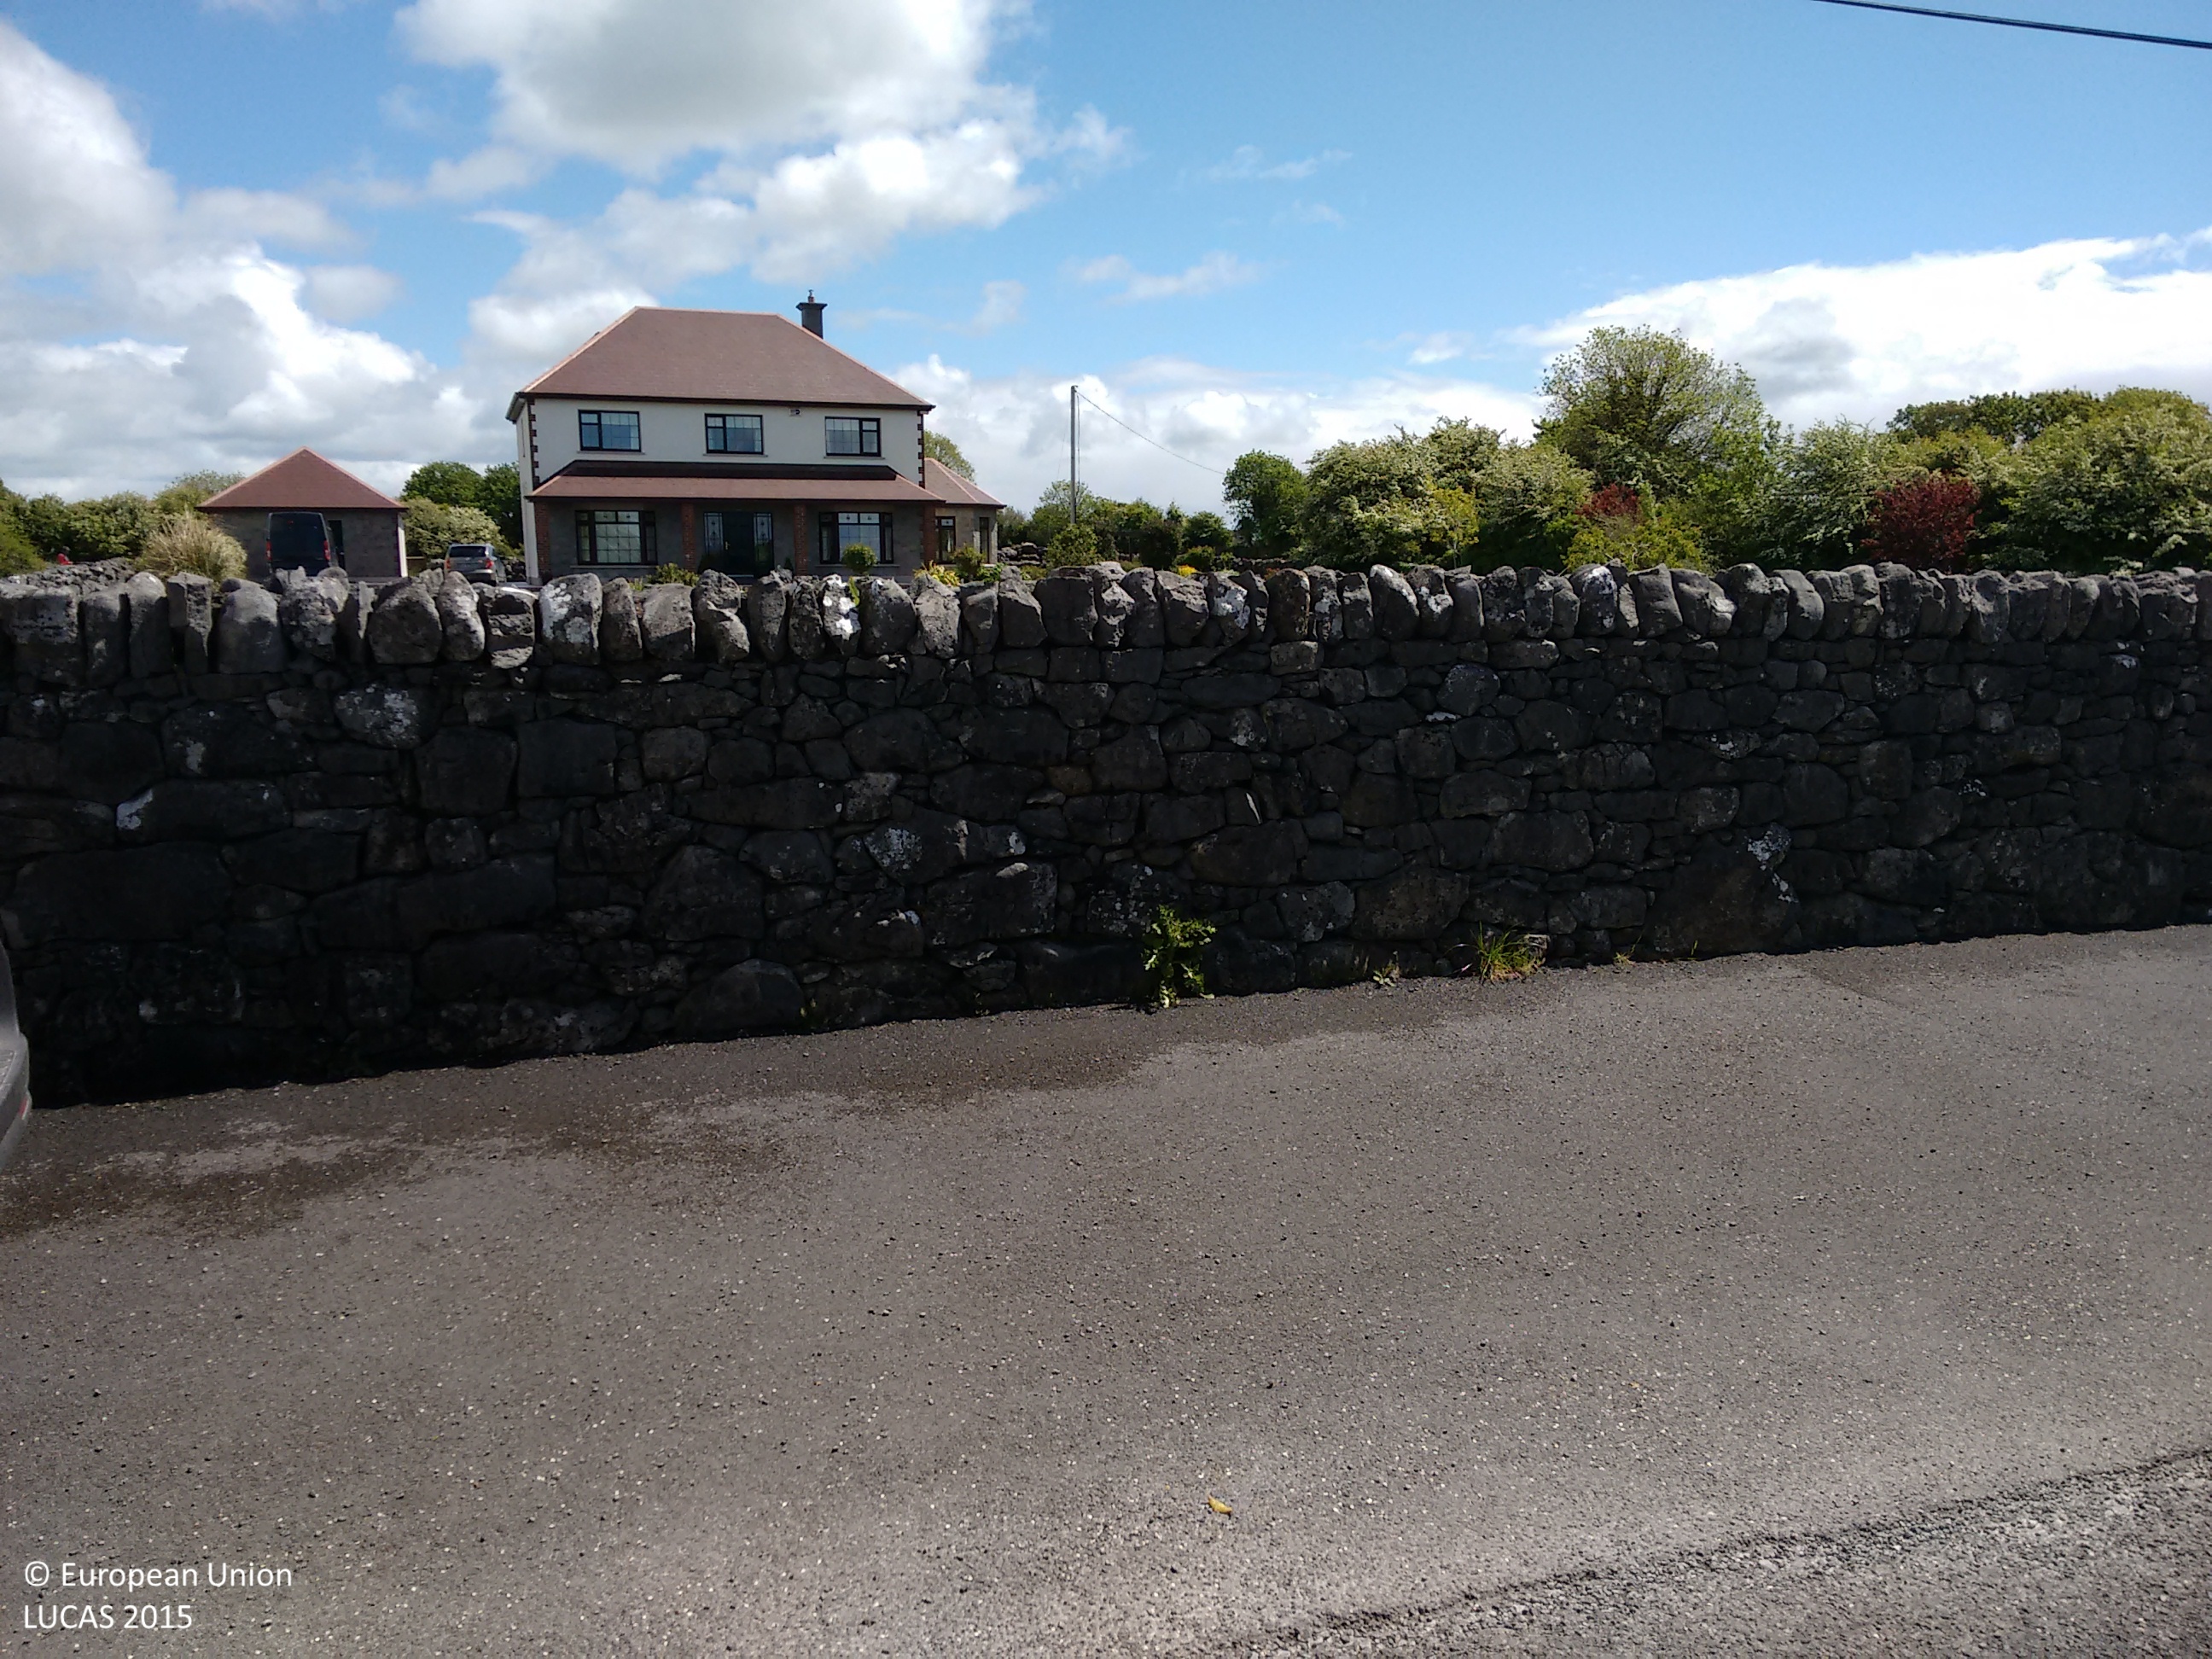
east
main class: Grassland
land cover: Grassland without tree/shrub cover
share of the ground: > 75 %
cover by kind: herbaceous plants 95 %, shrubs 5 %
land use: Agriculture (excluding fallow land and kitchen gardens)
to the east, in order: Abandoned hedges; Artificial constructions in urban areas; Grassland without tree/shrub cover; Abandoned hedges; Grassland without tree/shrub cover; Broadleaved woodland; Dry stone walls; Grassland without tree/shrub cover; Broadleaved woodland; Grassland without tree/shrub cover
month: May
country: IE
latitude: 53.4076
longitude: -9.0322
